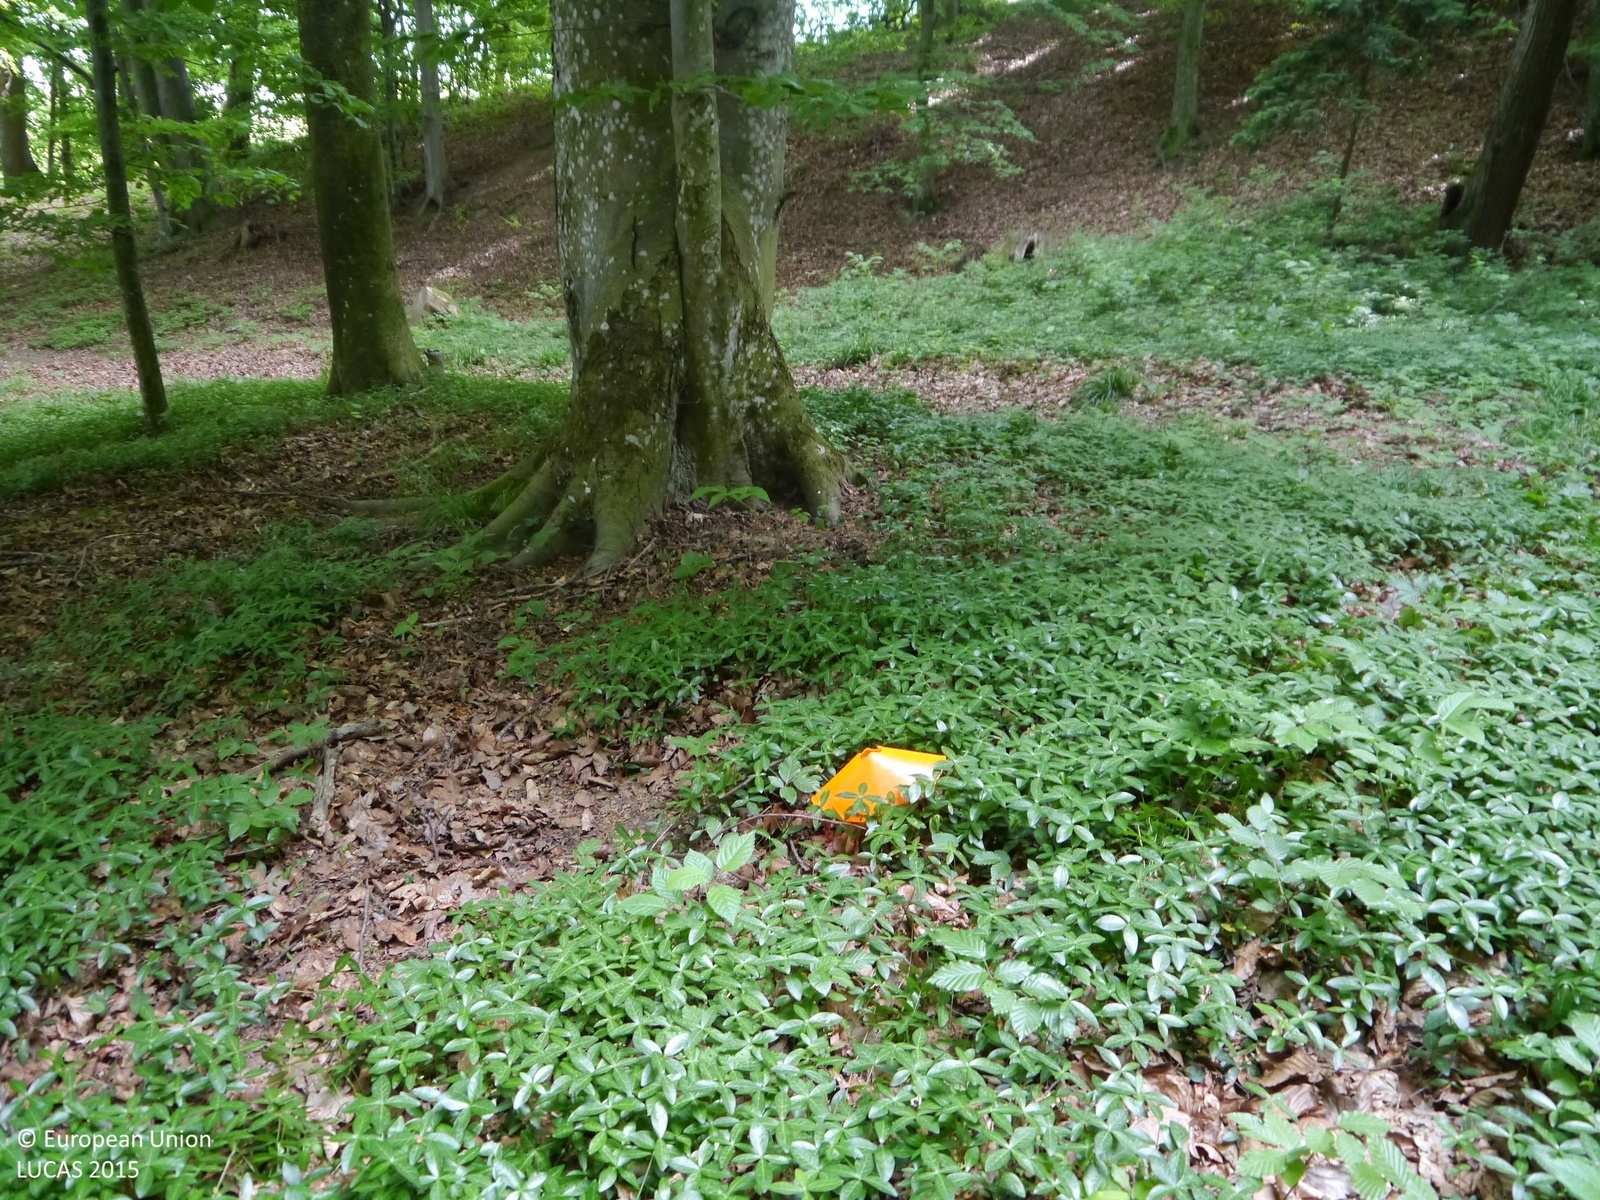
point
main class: Woodland
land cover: Broadleaved woodland
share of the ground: > 75 %
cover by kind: broadleaved forest trees 95 %, herbaceous plants 5 %
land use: Forestry
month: May
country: AT
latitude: 46.9593
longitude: 15.6639
